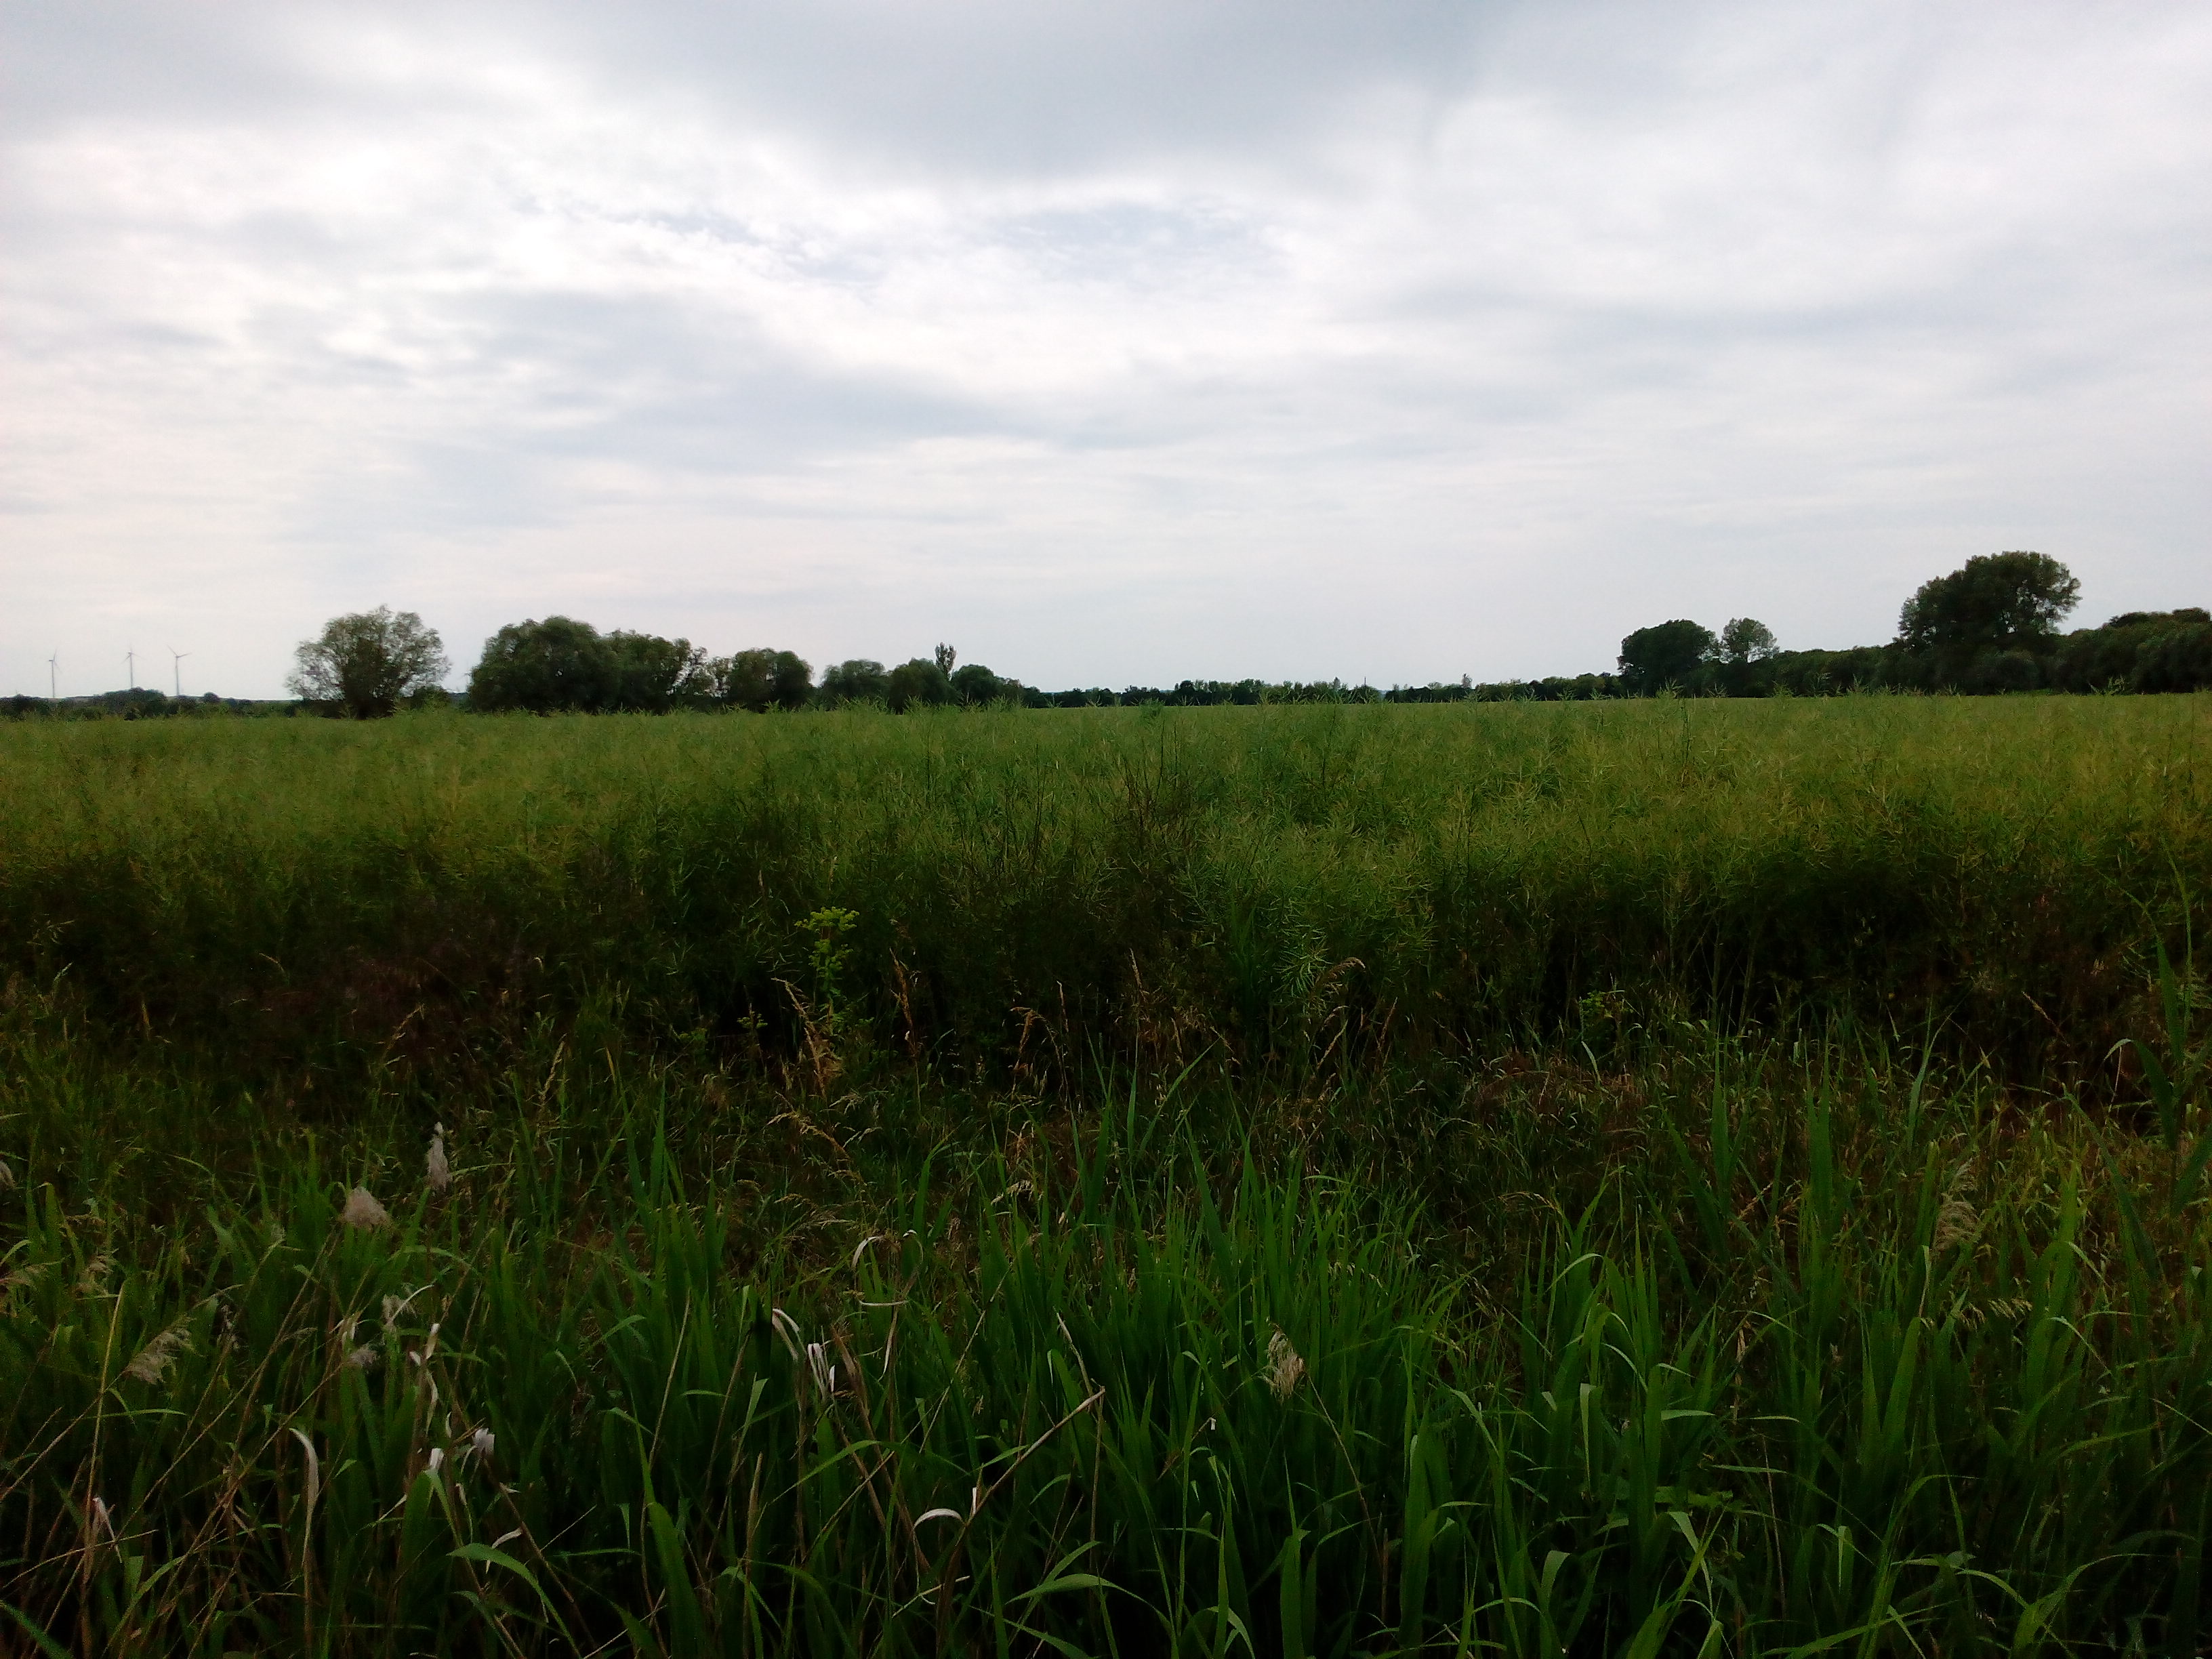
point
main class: Cropland
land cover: Rape and turnip rape
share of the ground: > 75 %
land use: Agriculture (excluding fallow land and kitchen gardens)
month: June
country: DE
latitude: 51.2226
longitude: 11.0163
